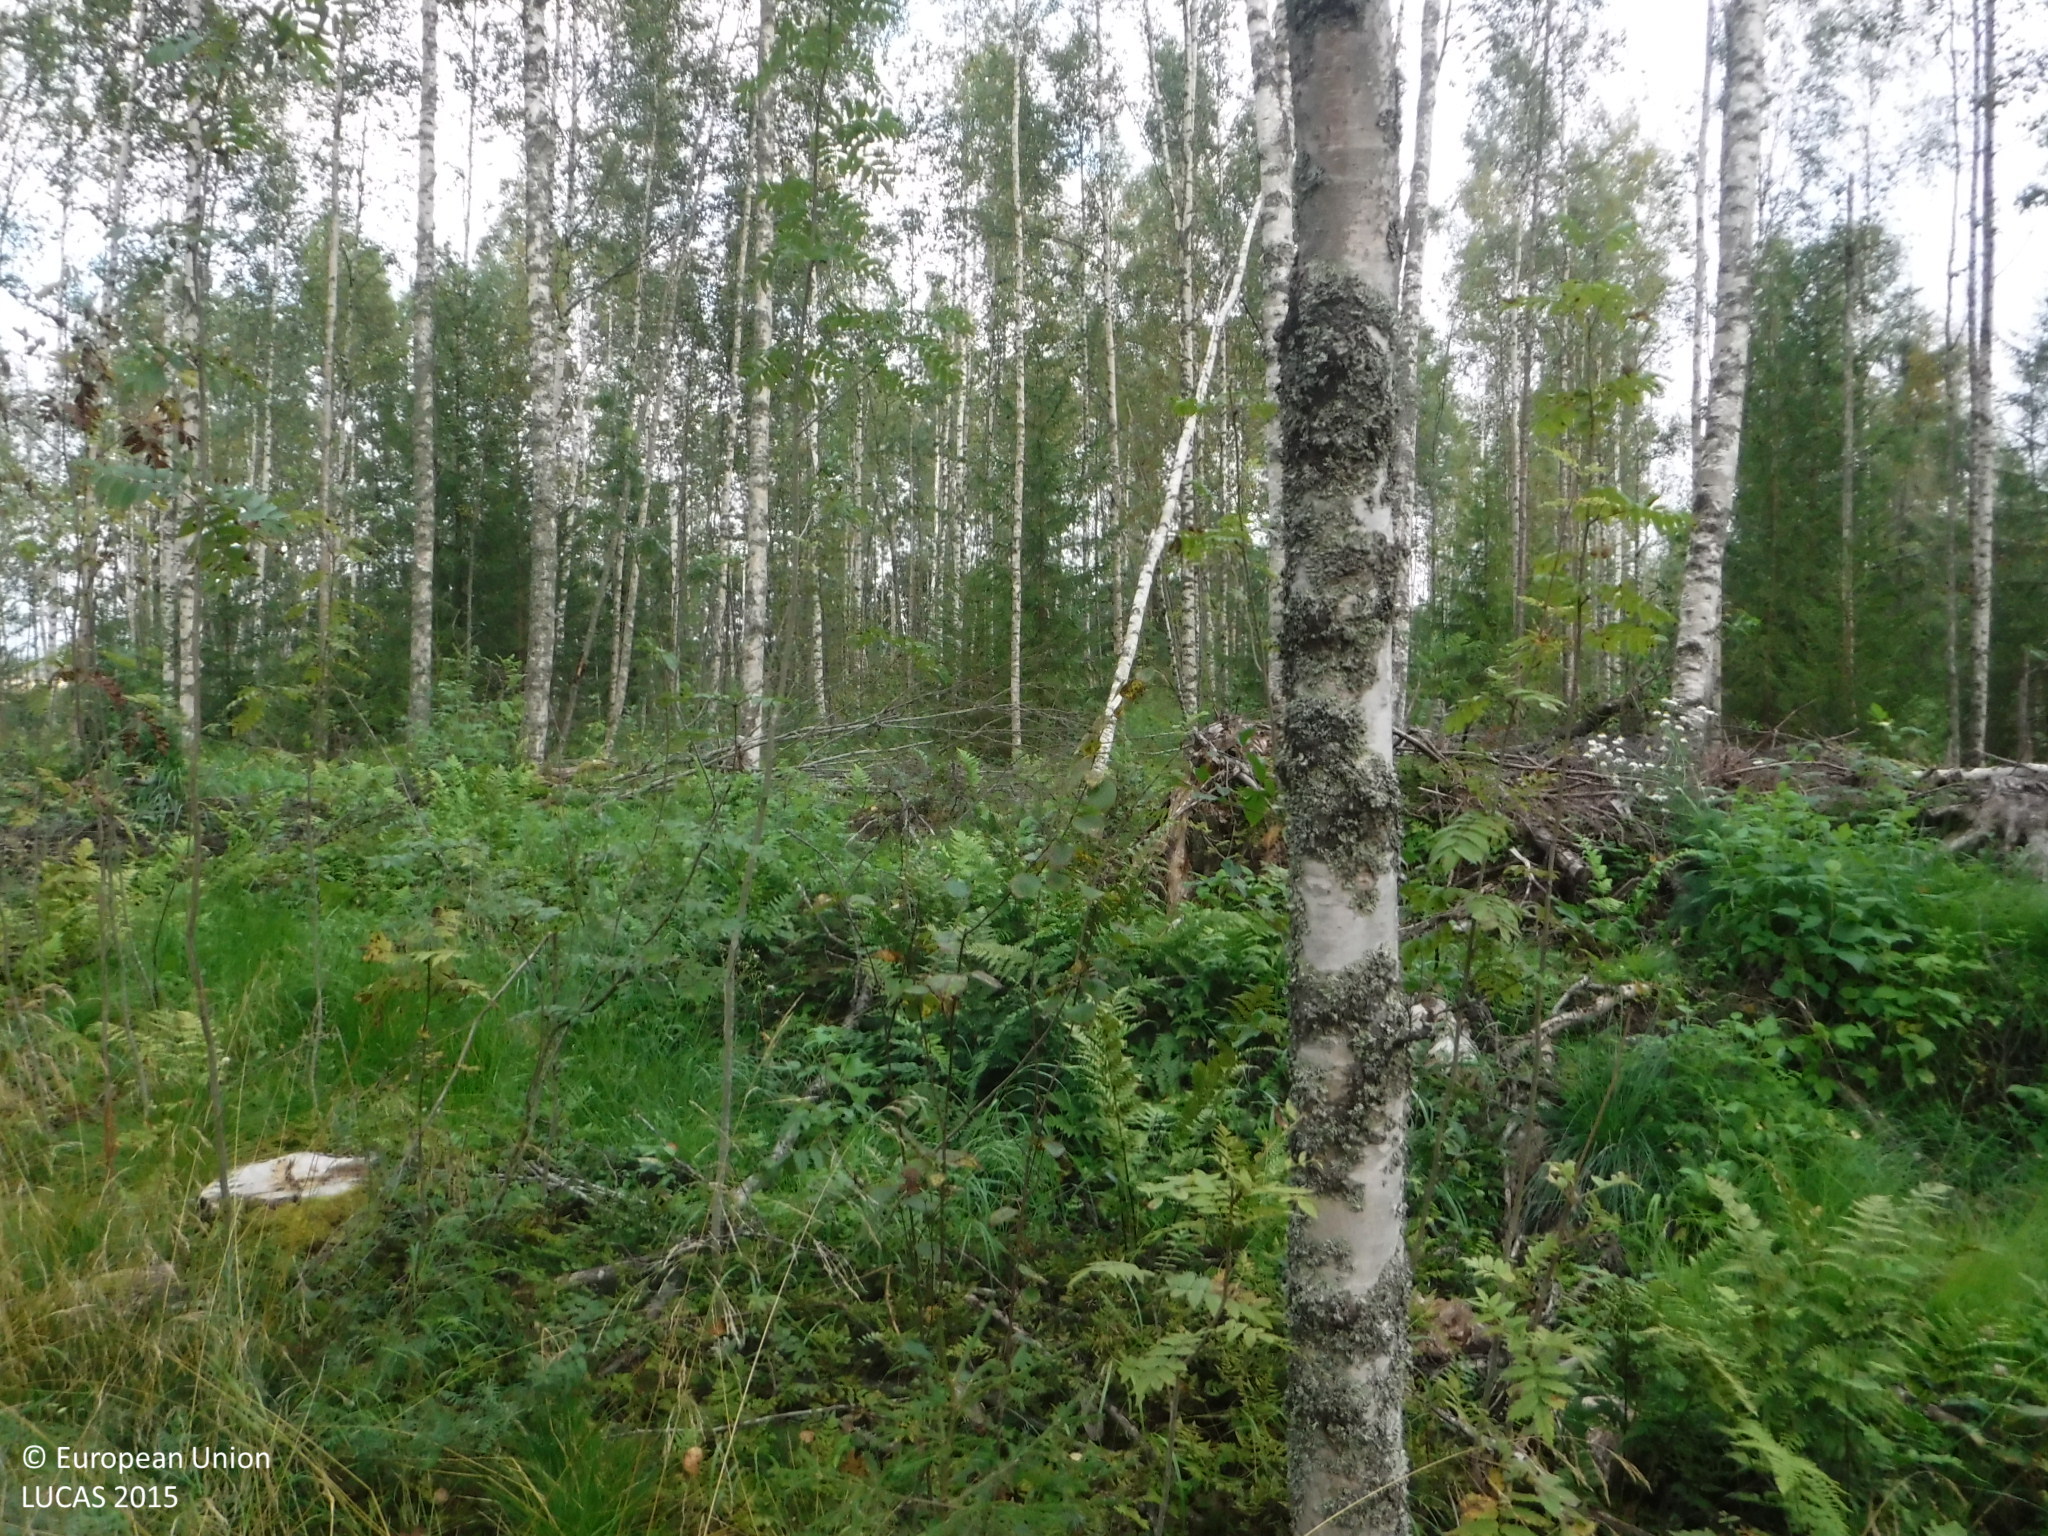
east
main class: Woodland
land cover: Broadleaved woodland
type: non-riverine alder, birch or aspen forest
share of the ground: 25 - 50 %
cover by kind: herbaceous plants 60 %, broadleaved forest trees 35 %, shrubs 5 %
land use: Forestry
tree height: > 5 m
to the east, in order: Broadleaved woodland; Ditches and canals; Broadleaved woodland; Groves; Grass margins; Barley
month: September
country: FI
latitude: 61.3479
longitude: 21.9662
